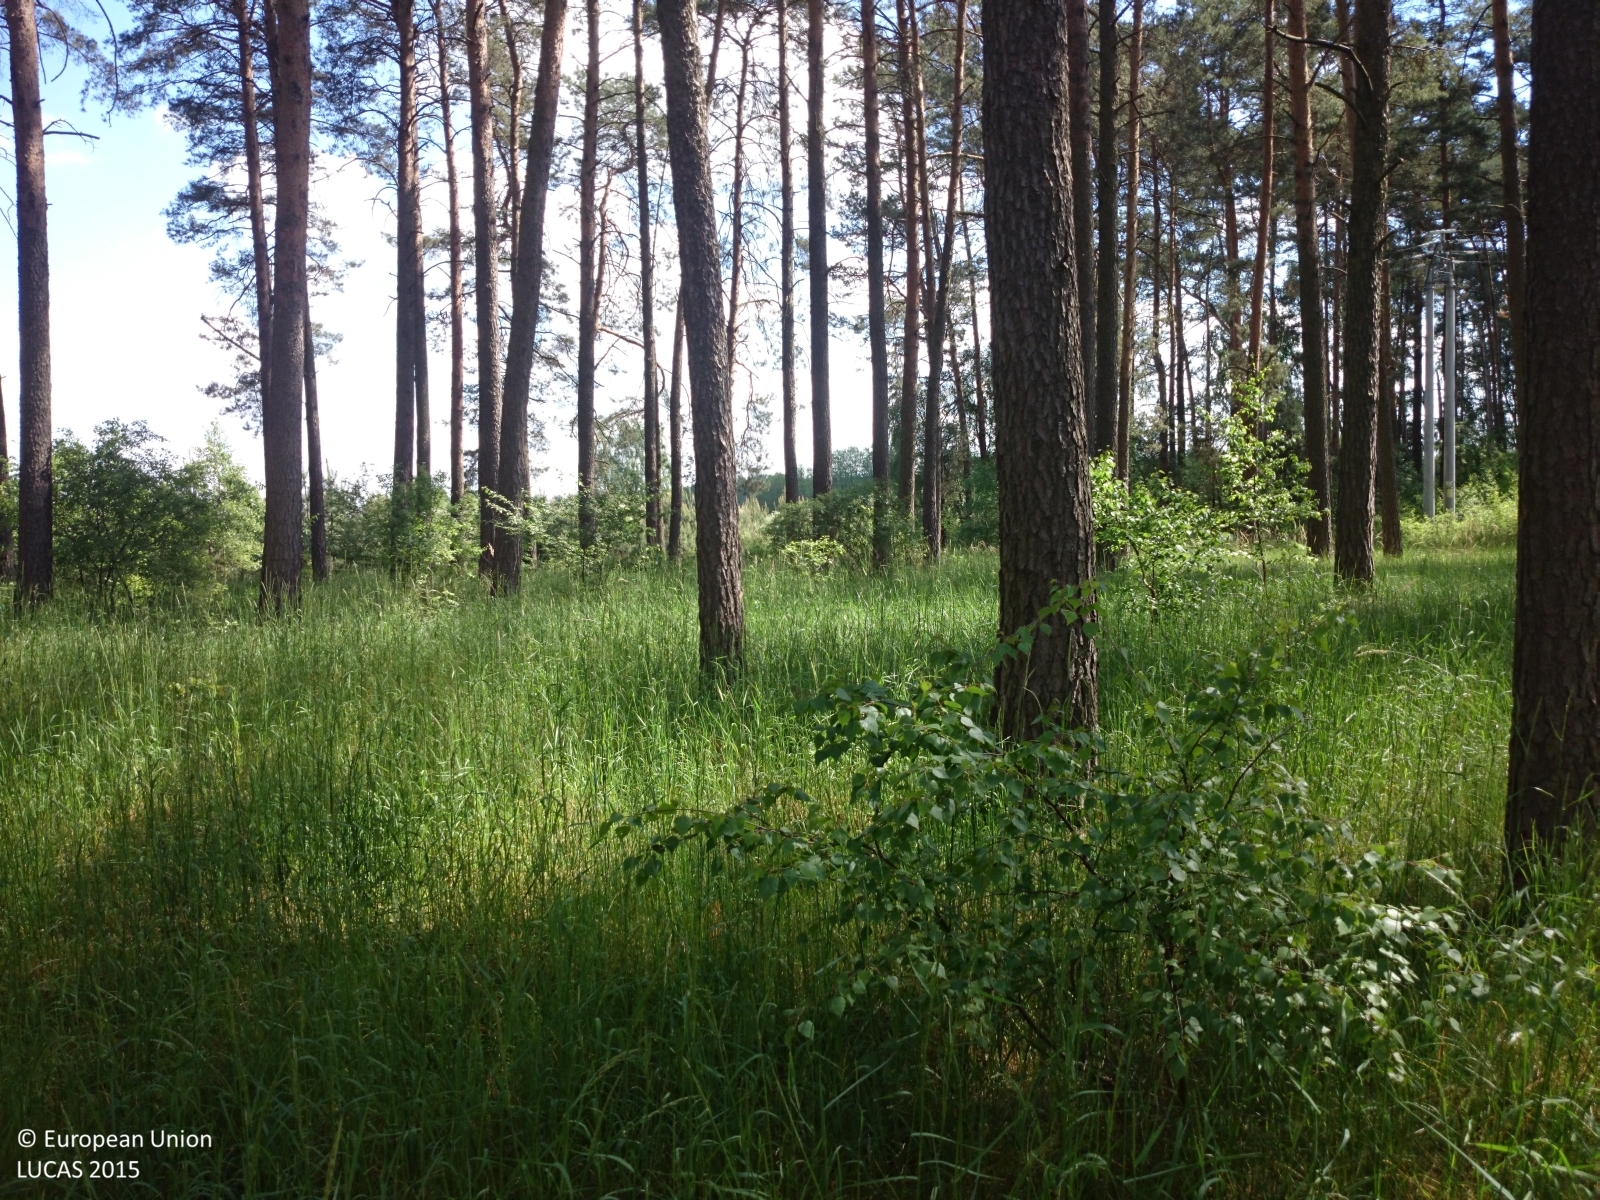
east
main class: Woodland
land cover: Pine dominated coniferous woodland
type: hemiboreal forest and nemoral coniferous forest and mixed broadleaved-coniferous forest
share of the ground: 50 - 75 %
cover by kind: coniferous forest trees 65 %, herbaceous plants 35 %
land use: Forestry
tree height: > 5 m
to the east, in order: Pine dominated coniferous woodland; Tracks; Electric lines; Pine dominated coniferous woodland; Grassland with sparse tree/shrub cover; Managed hedges; Grassland with sparse tree/shrub cover; Paved roads, cycling and walking lanes; Grass margins; Single bushes/trees; Grass margins; Triticale; Barley
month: May
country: PL
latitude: 52.5313
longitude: 15.6503
